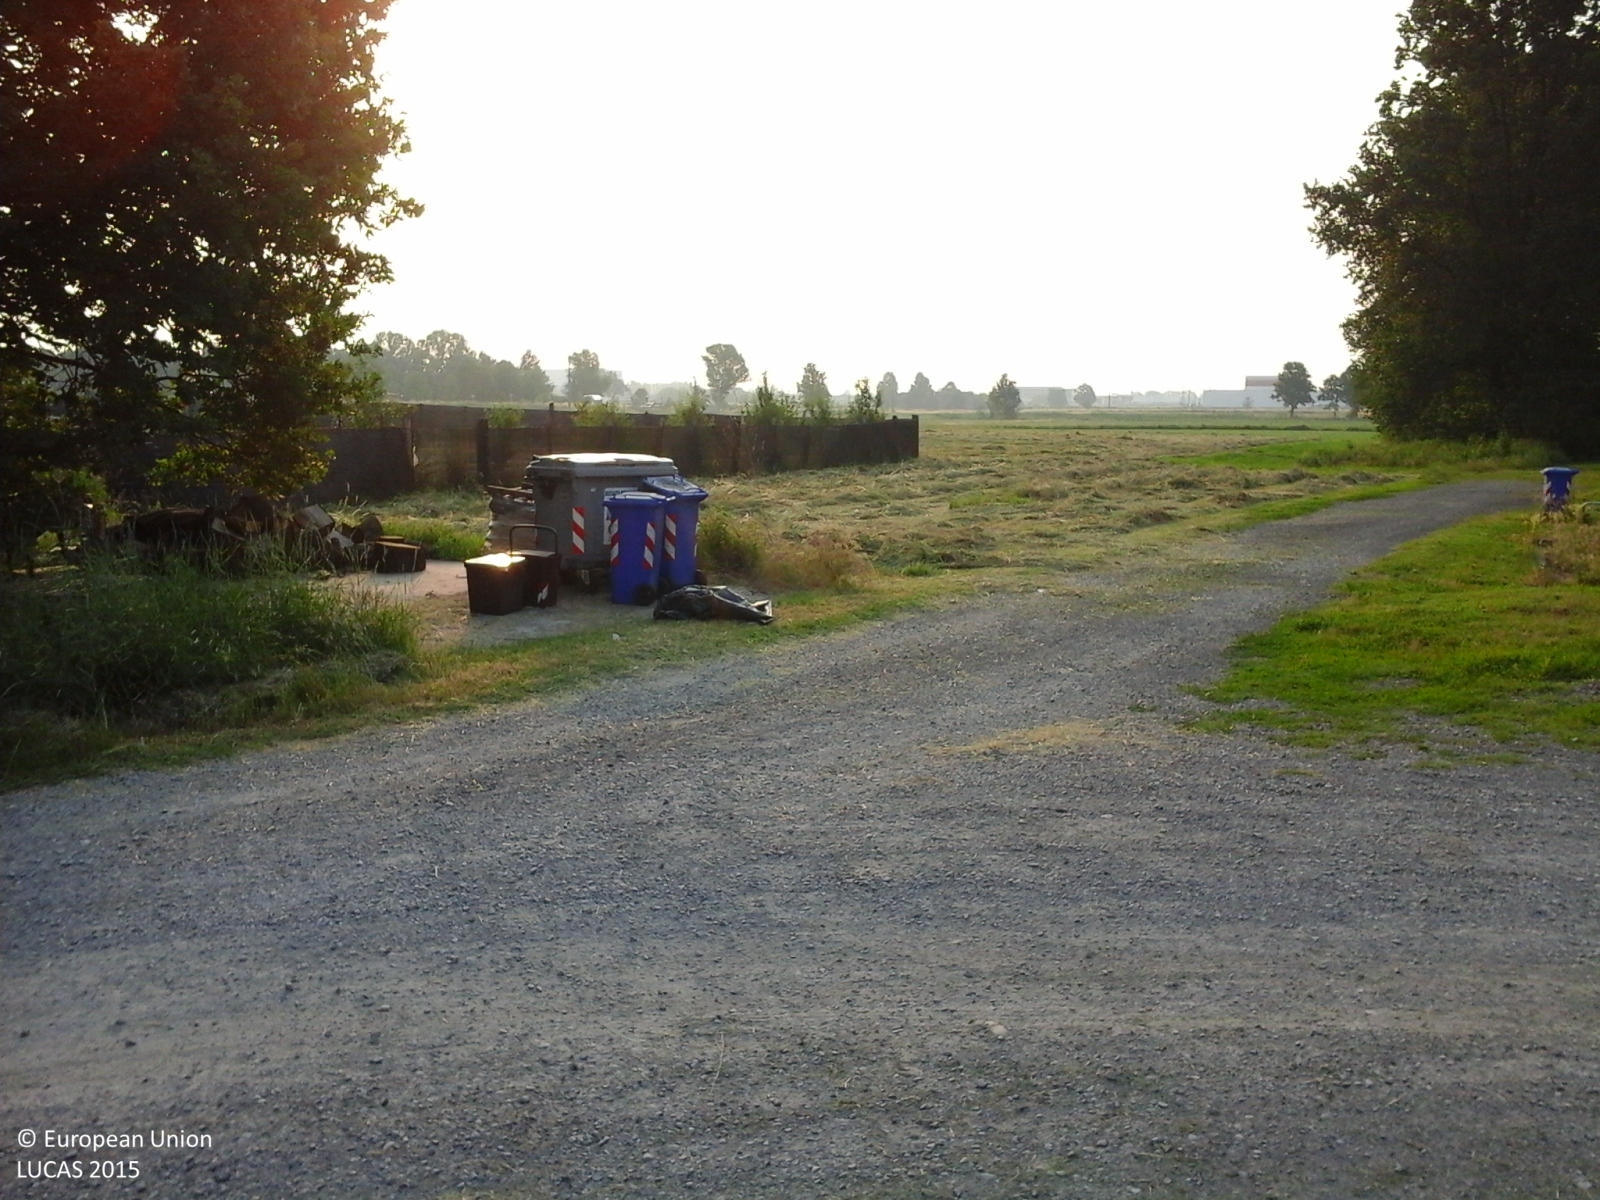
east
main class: Grassland
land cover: Grassland with sparse tree/shrub cover
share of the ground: > 75 %
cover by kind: herbaceous plants 95 %, broadleaved forest trees 5 %
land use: Agriculture (excluding fallow land and kitchen gardens)
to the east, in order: Grassland with sparse tree/shrub cover; Tracks; Temporary grasslands; Lucerne; Spontaneously vegetated surfaces; Lucerne; Ditches and canals; Lucerne
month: May
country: IT
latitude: 44.8734
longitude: 10.1642
